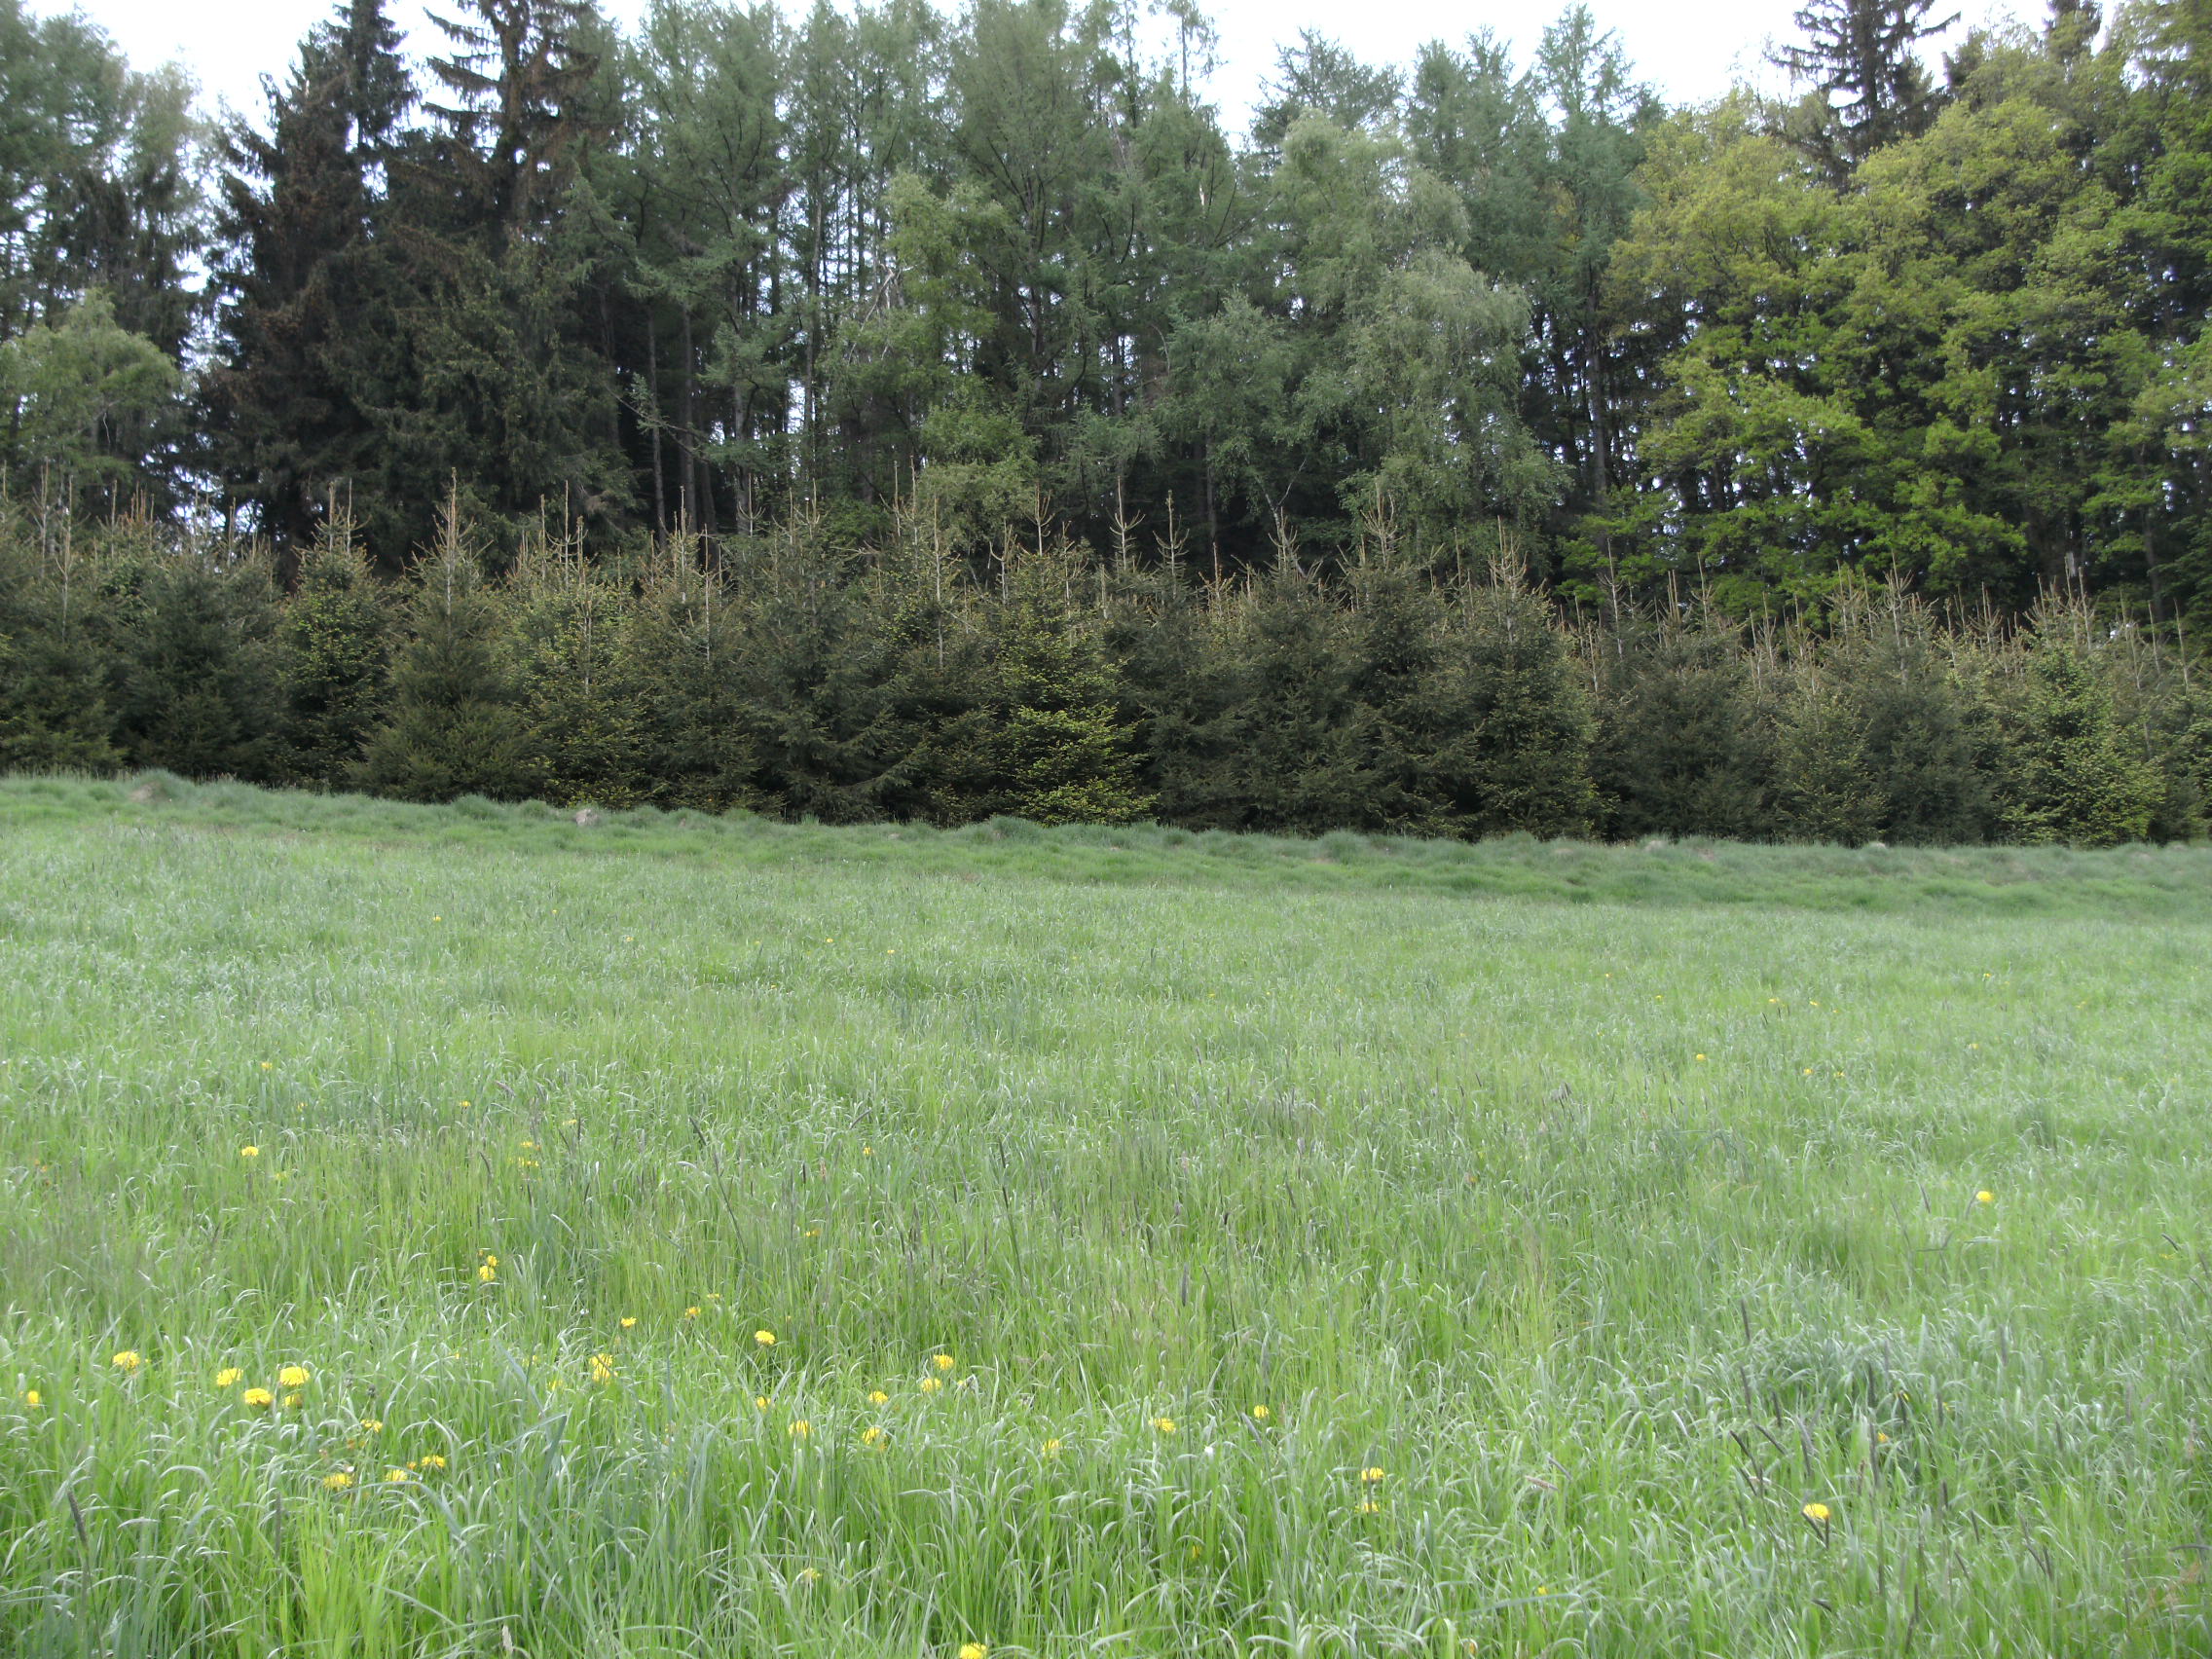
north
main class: Grassland
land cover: Grassland without tree/shrub cover
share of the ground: > 75 %
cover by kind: herbaceous plants 100 %
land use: Agriculture (excluding fallow land and kitchen gardens)
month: May
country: AT
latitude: 48.1188
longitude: 13.3440
